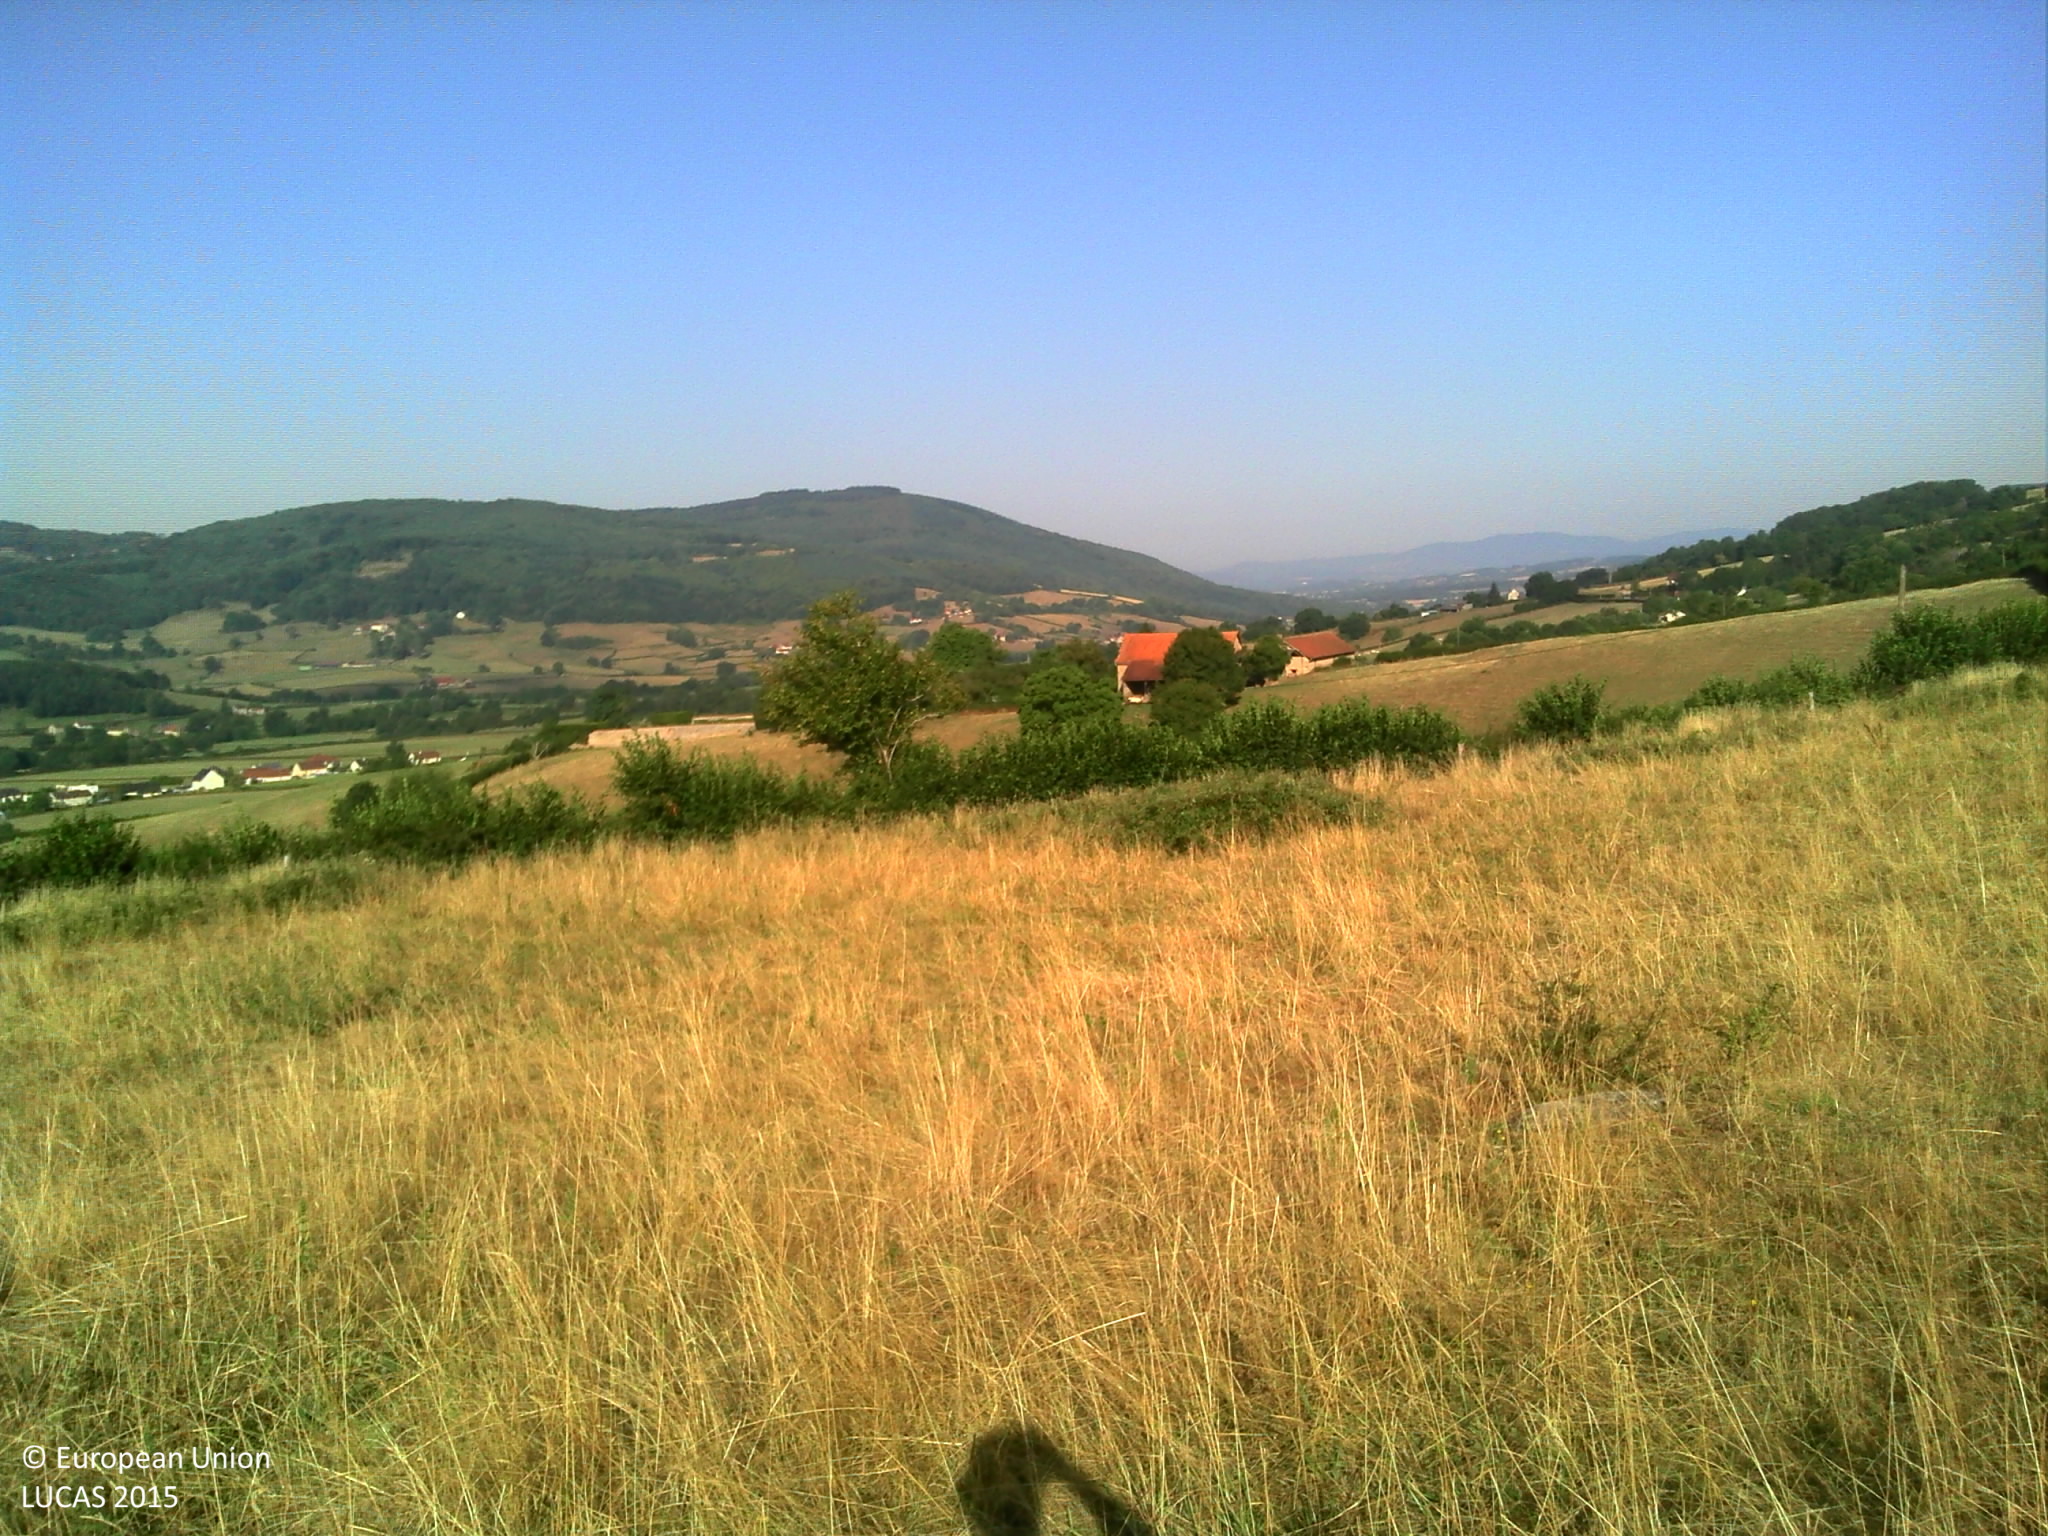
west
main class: Grassland
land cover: Grassland without tree/shrub cover
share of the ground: > 75 %
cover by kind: herbaceous plants 100 %
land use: Agriculture (excluding fallow land and kitchen gardens)
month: August
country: FR
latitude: 46.8516
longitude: 4.3476
